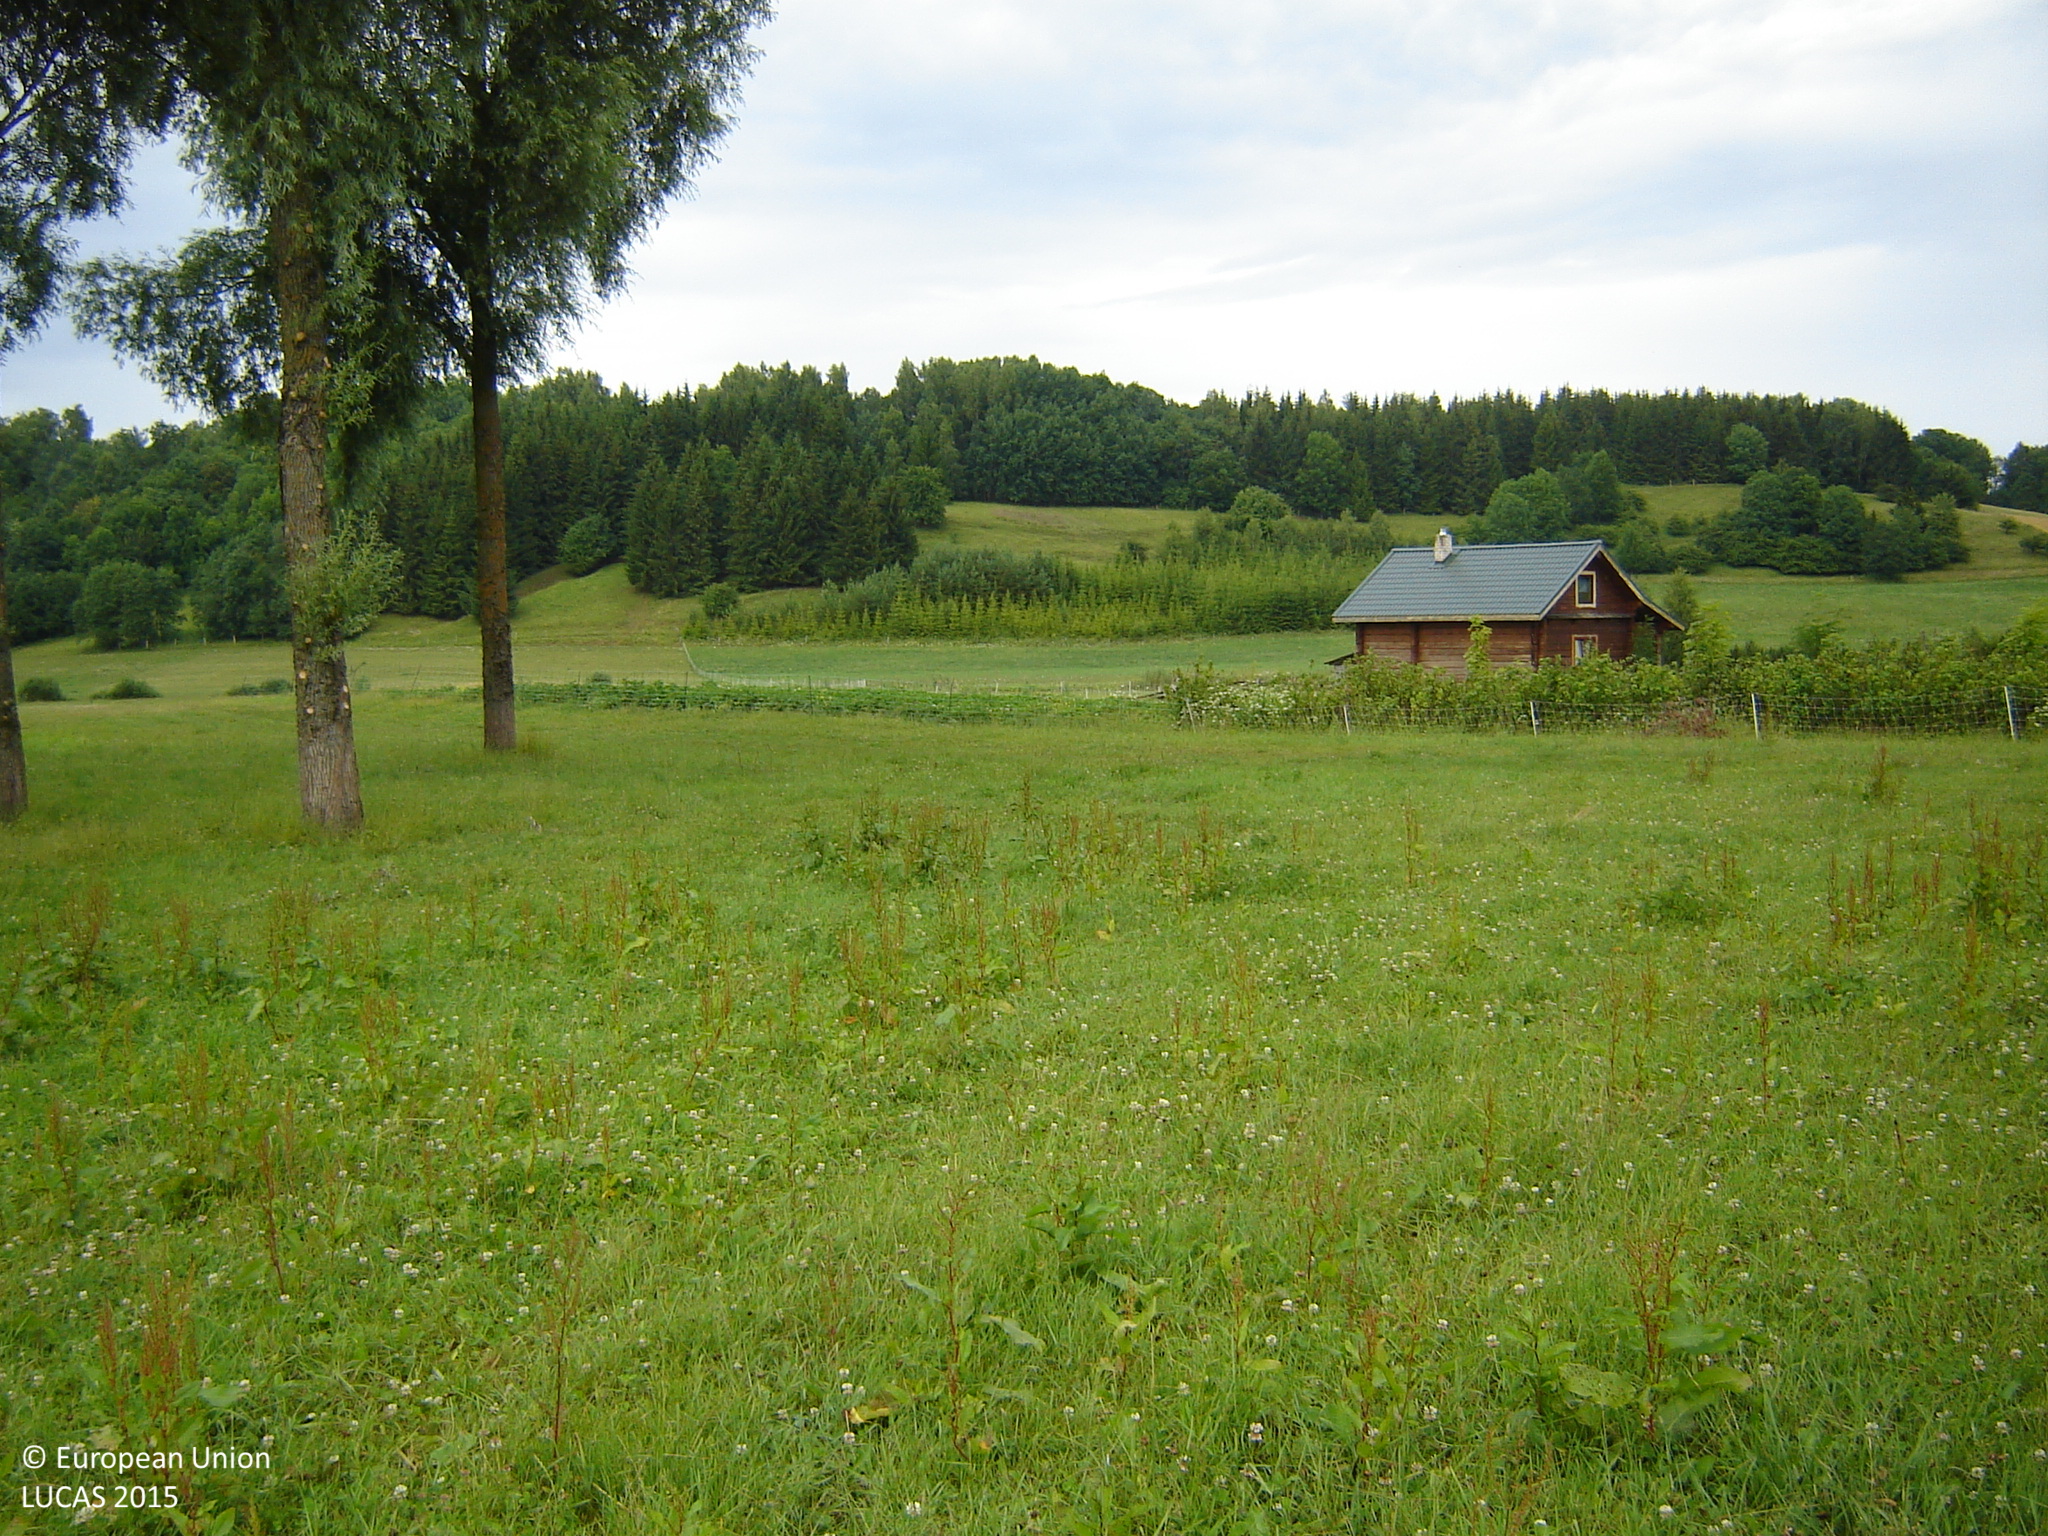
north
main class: Grassland
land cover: Grassland without tree/shrub cover
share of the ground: > 75 %
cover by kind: herbaceous plants 100 %
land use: Agriculture (excluding fallow land and kitchen gardens)
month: July
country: LT
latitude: 55.3415
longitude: 25.4009
